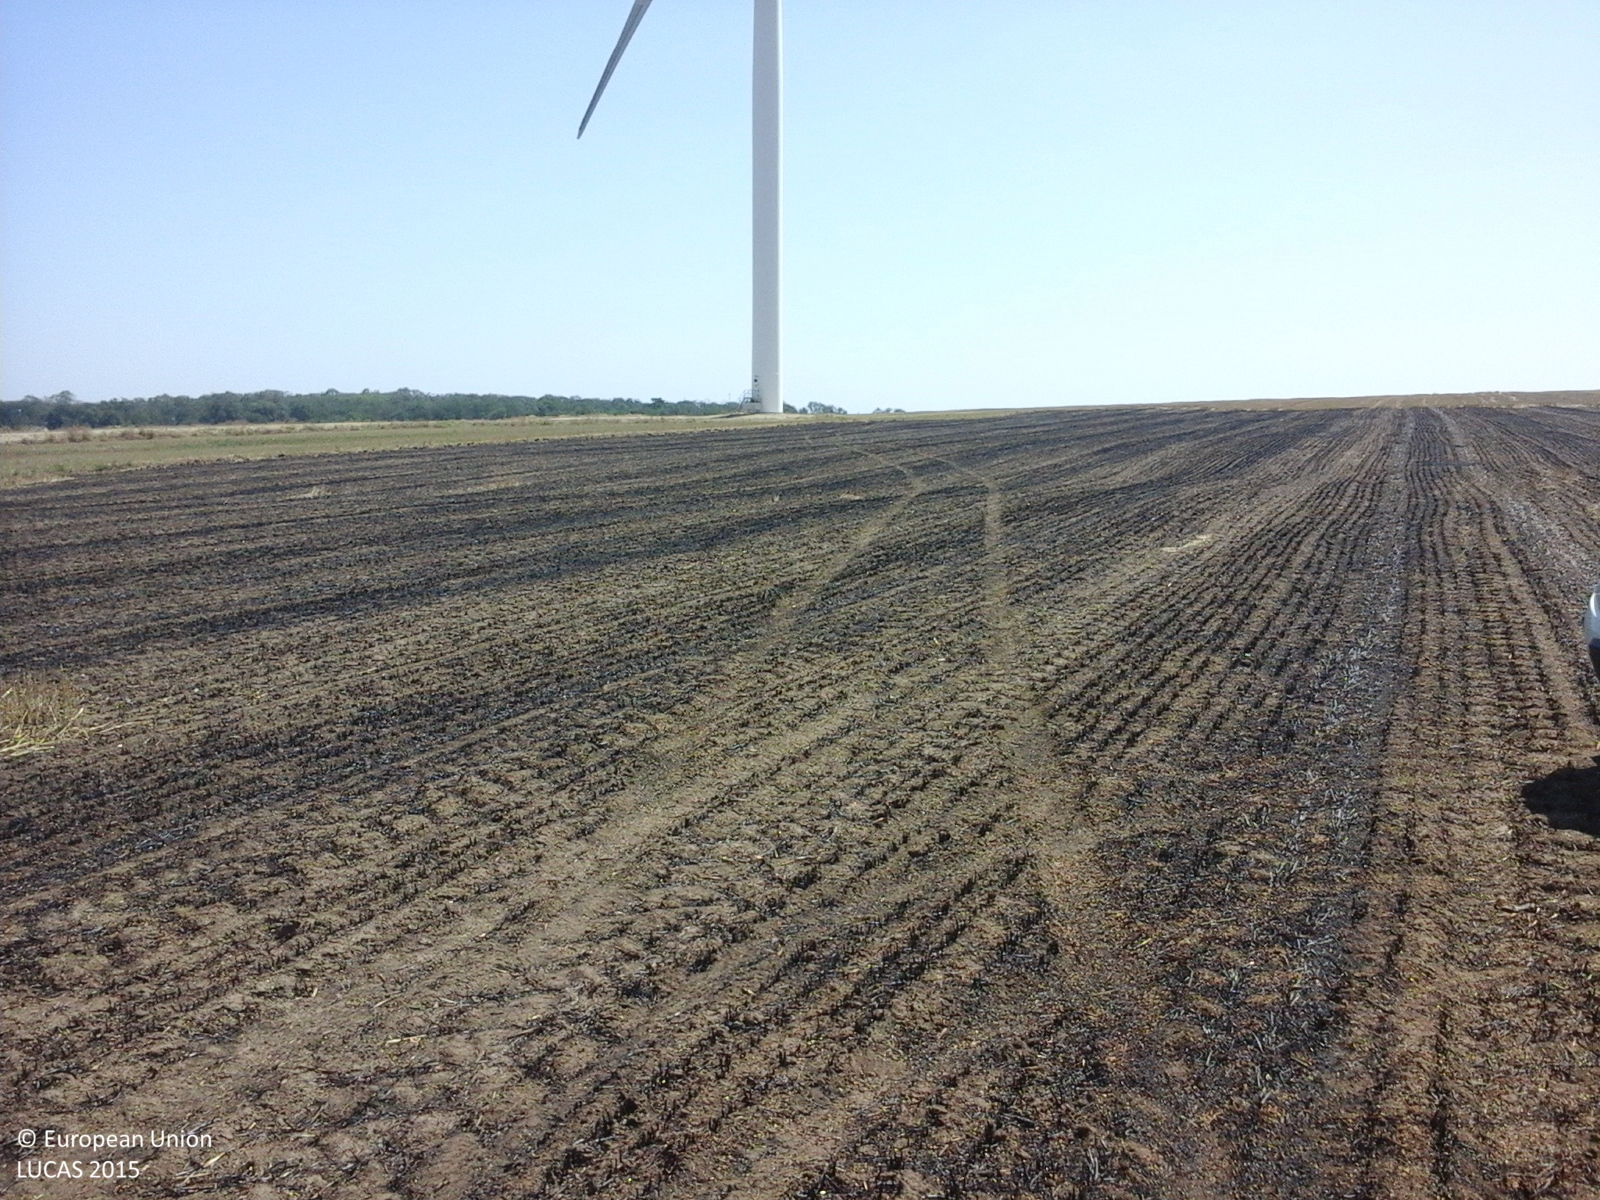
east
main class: Cropland
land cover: Common wheat
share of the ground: < 10 %
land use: Agriculture (excluding fallow land and kitchen gardens)
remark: Burnt area
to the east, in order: Common wheat; Other bare soil; Common wheat
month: August
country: RO
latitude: 44.3718
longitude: 28.3775
